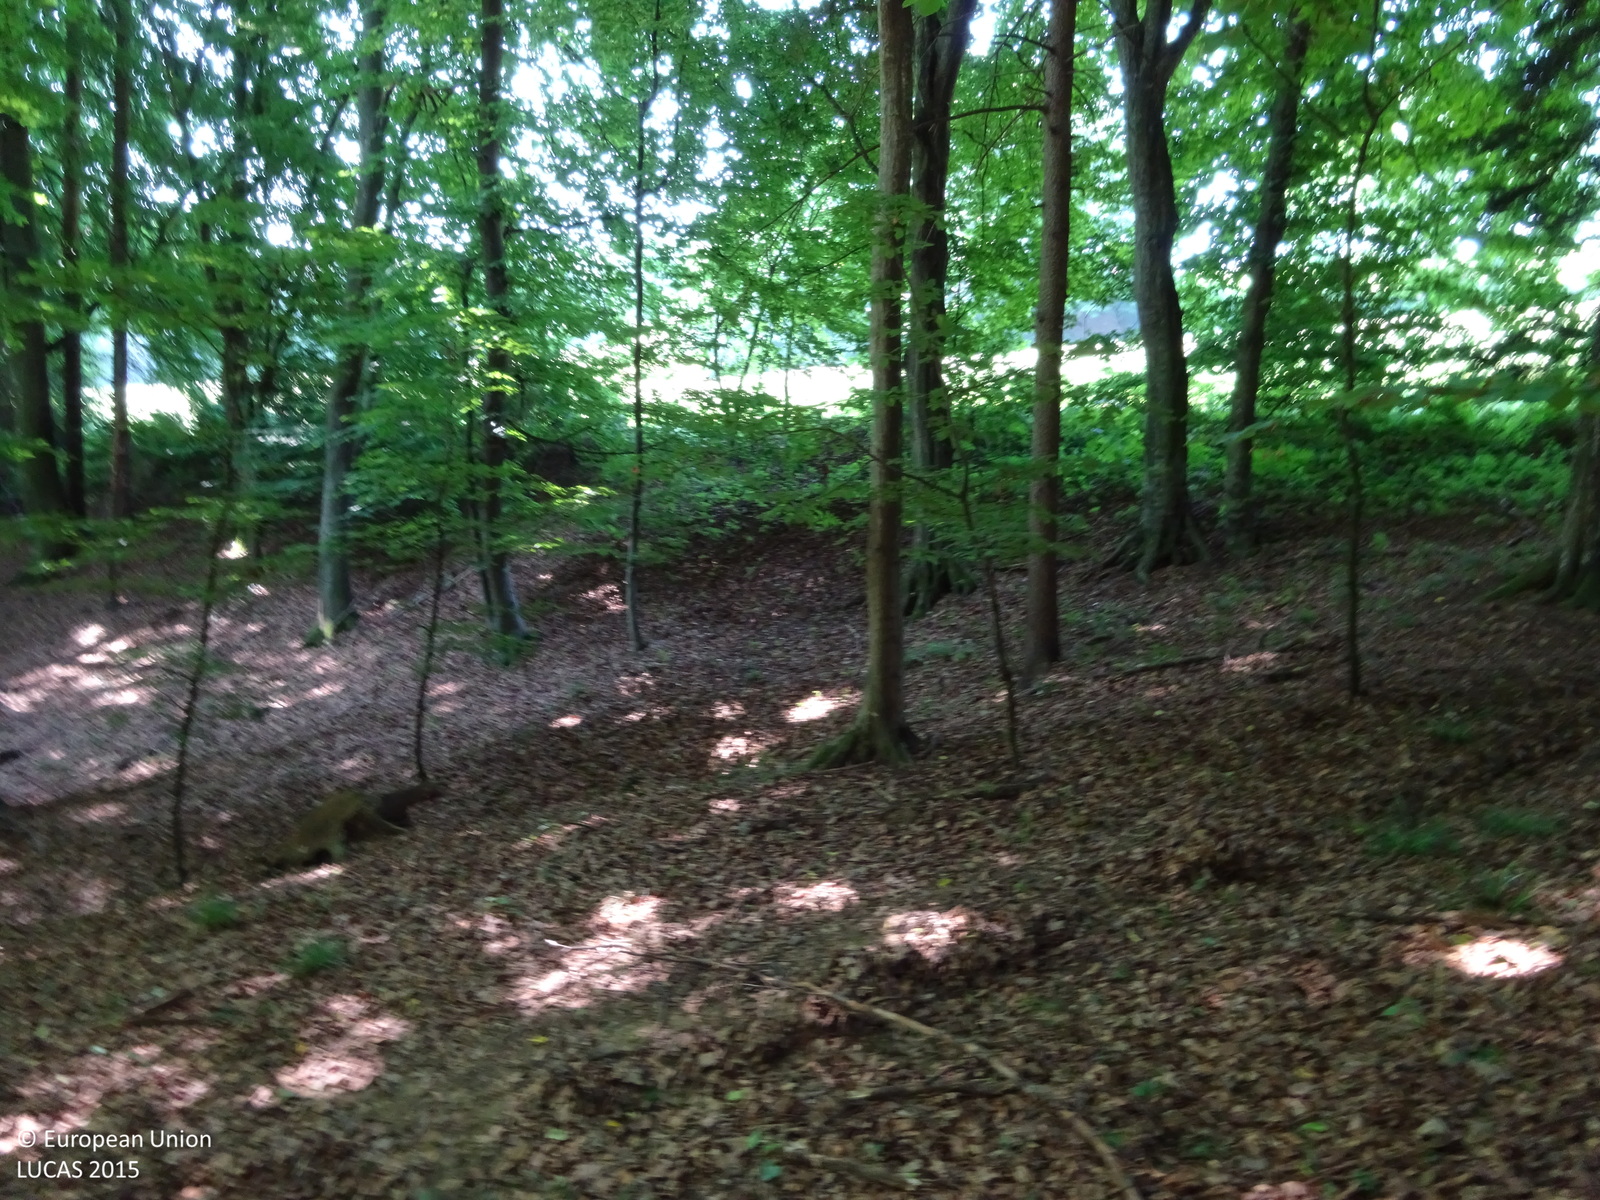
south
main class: Woodland
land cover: Broadleaved woodland
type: mountainous beech forest
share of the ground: > 75 %
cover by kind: broadleaved forest trees 100 %
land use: Forestry
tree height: > 5 m
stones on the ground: < 10 %
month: July
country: AT
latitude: 46.8900
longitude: 15.9459
